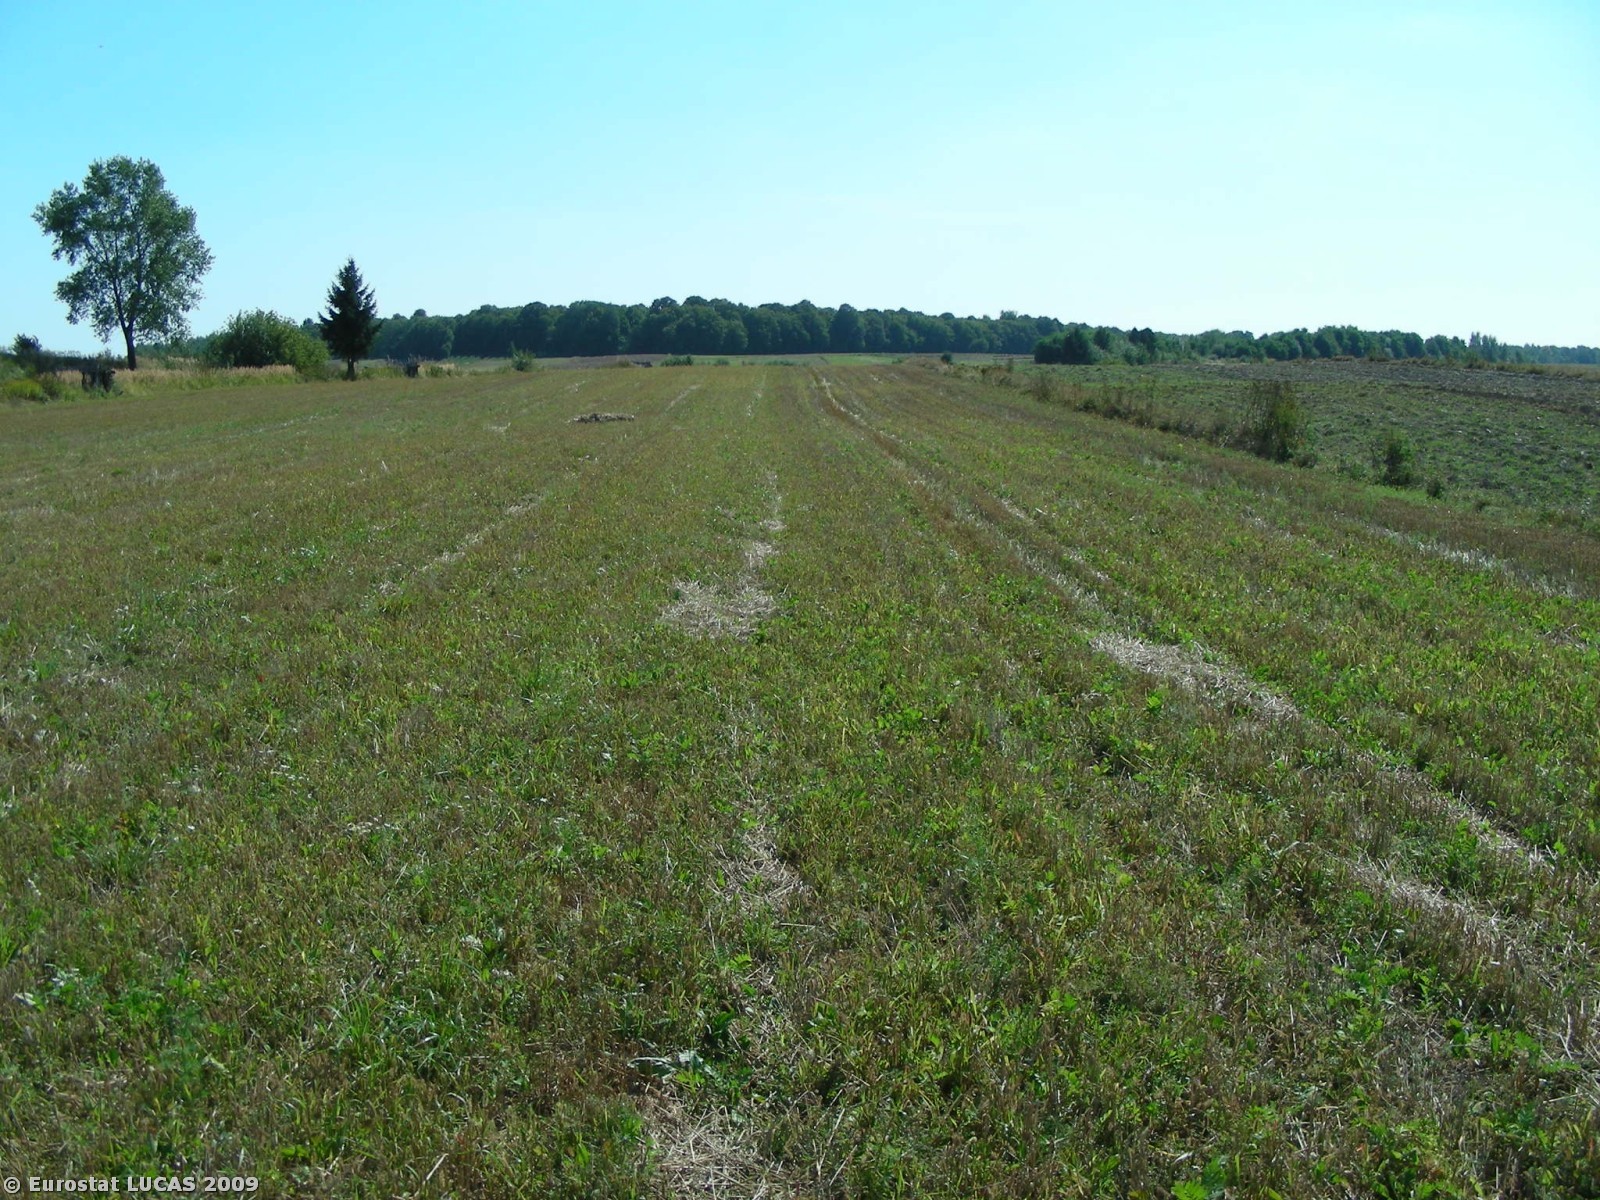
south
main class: Cropland
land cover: Common wheat
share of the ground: < 10 %
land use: Agriculture (excluding fallow land and kitchen gardens)
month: September
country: PL
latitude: 50.8944
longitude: 22.3331
